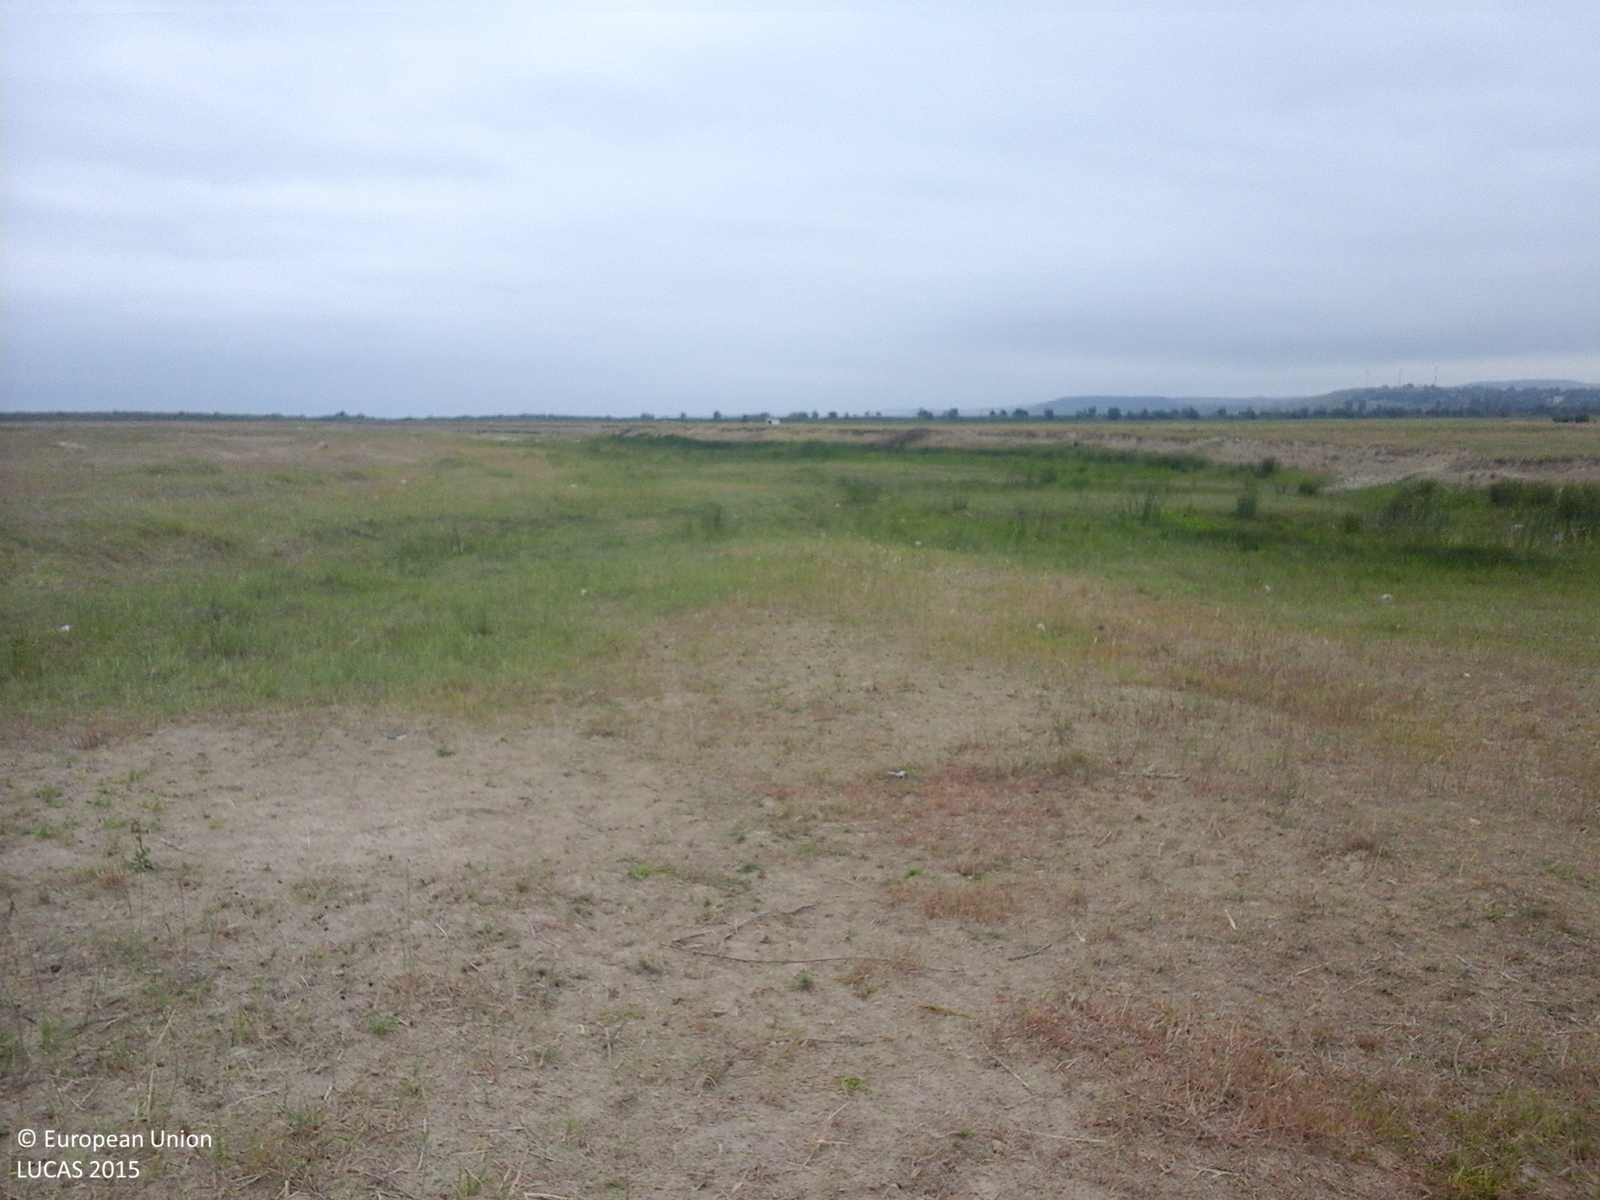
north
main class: Grassland
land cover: Grassland without tree/shrub cover
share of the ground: 25 - 50 %
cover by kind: herbaceous plants 100 %
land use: Agriculture (excluding fallow land and kitchen gardens)
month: June
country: RO
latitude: 47.1314
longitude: 26.6354
